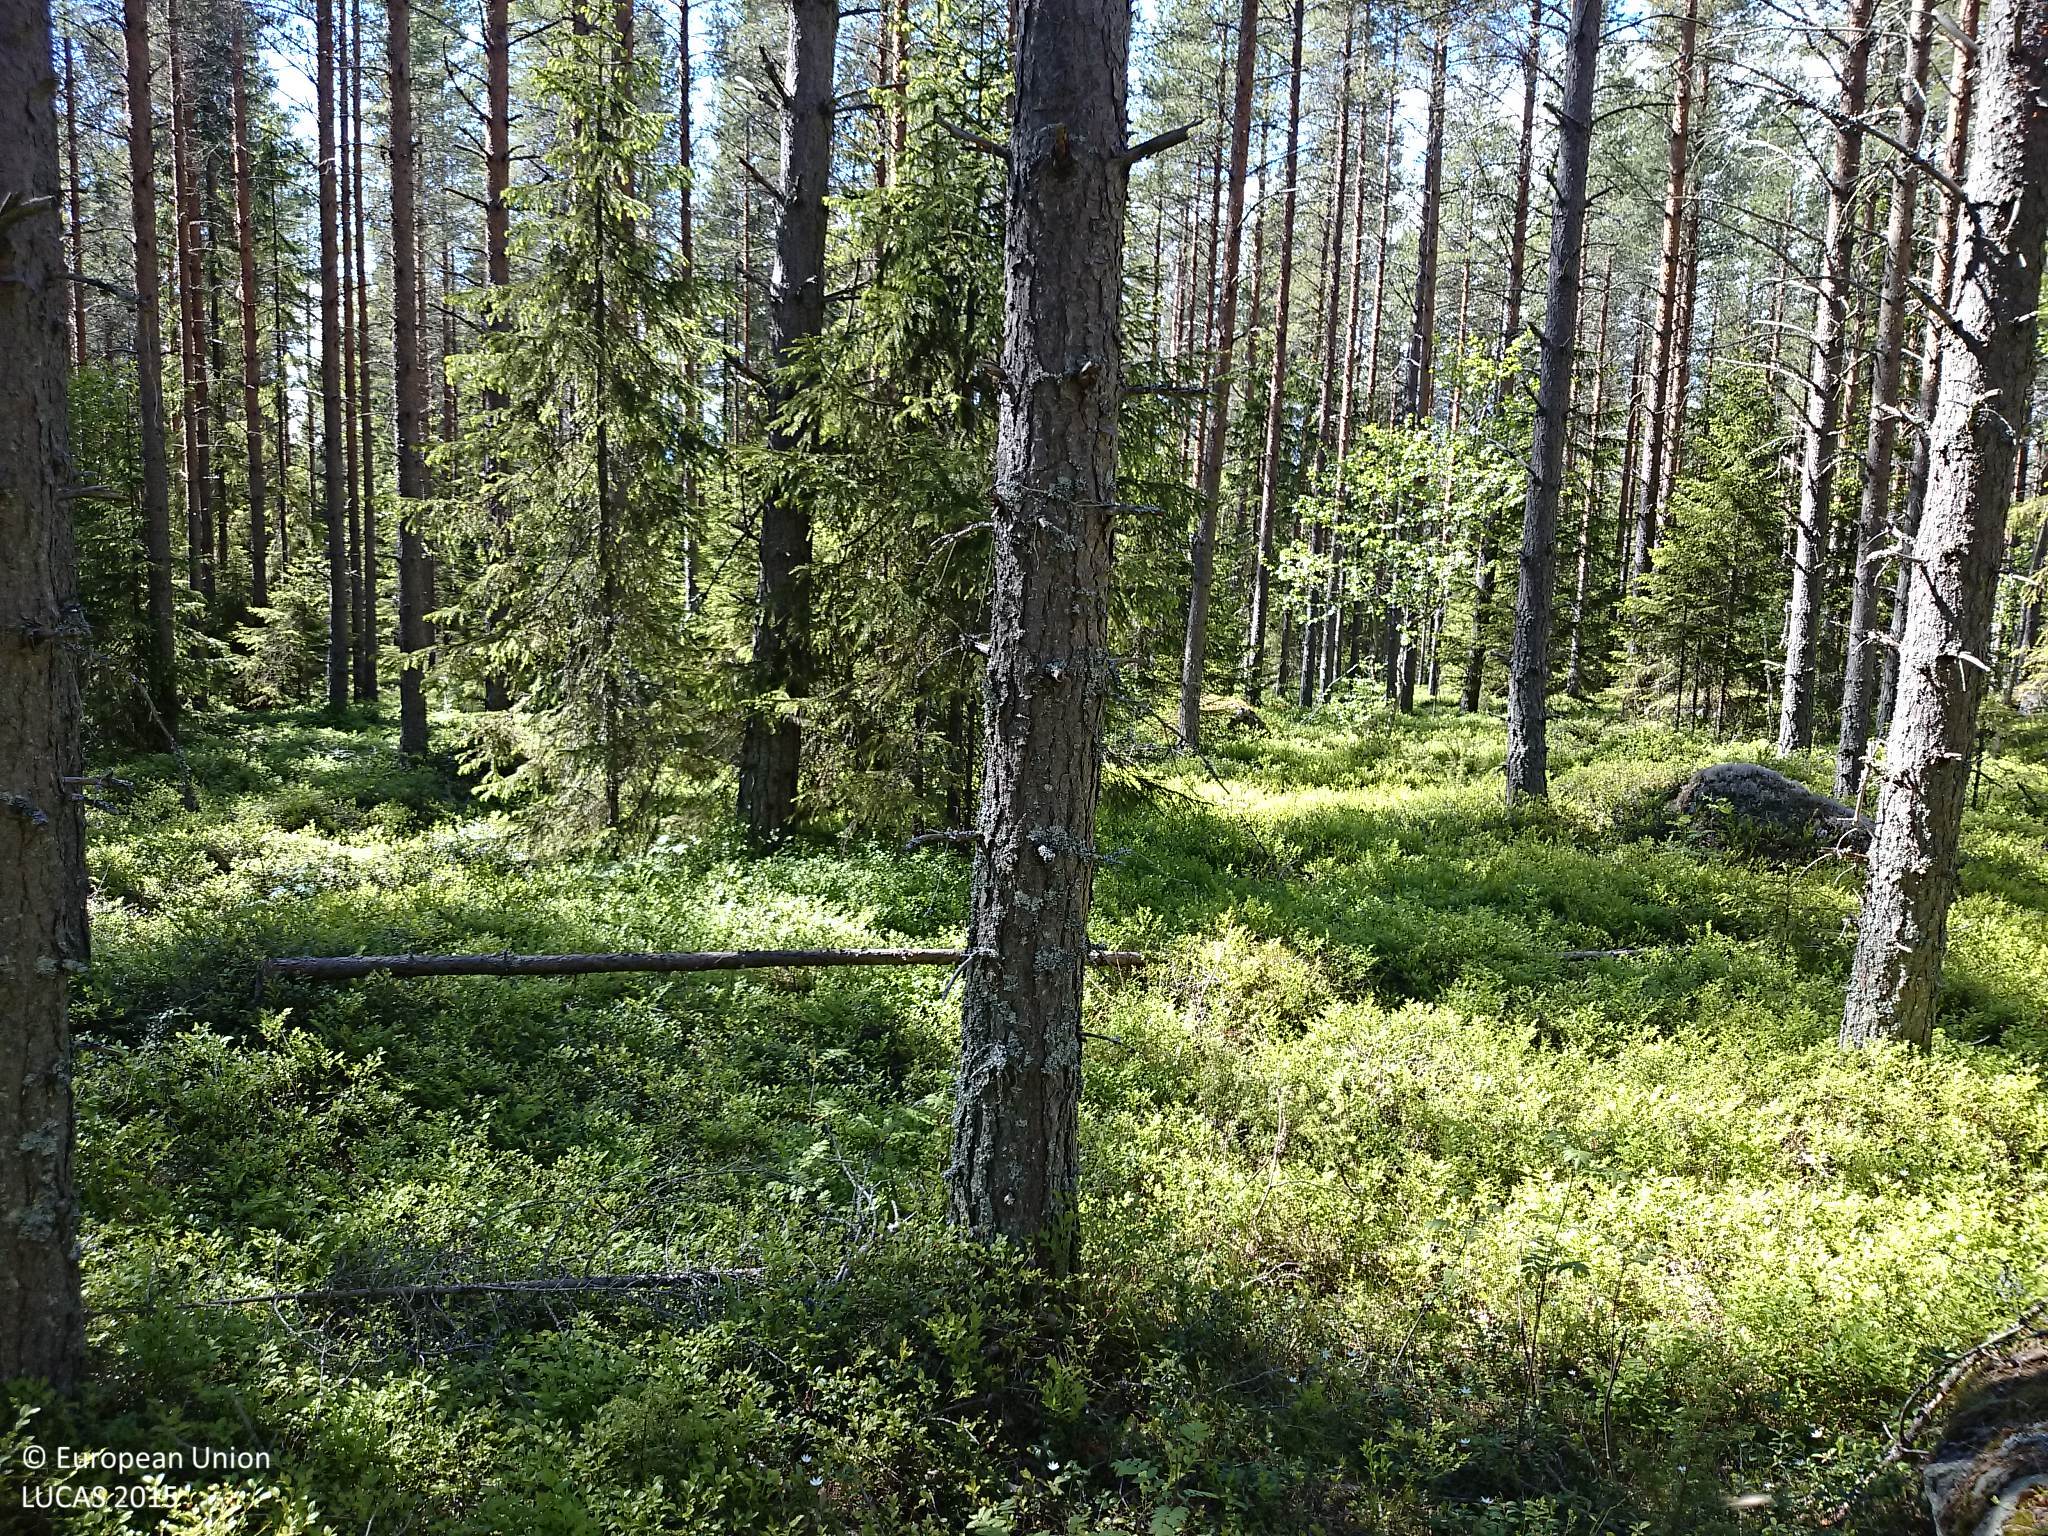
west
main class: Woodland
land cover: Pine dominated coniferous woodland
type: boreal forest
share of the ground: 50 - 75 %
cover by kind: coniferous forest trees 65 %, shrubs 35 %
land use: Forestry
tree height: > 5 m
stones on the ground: > 50 %
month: June
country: SE
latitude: 63.9597
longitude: 20.7436
